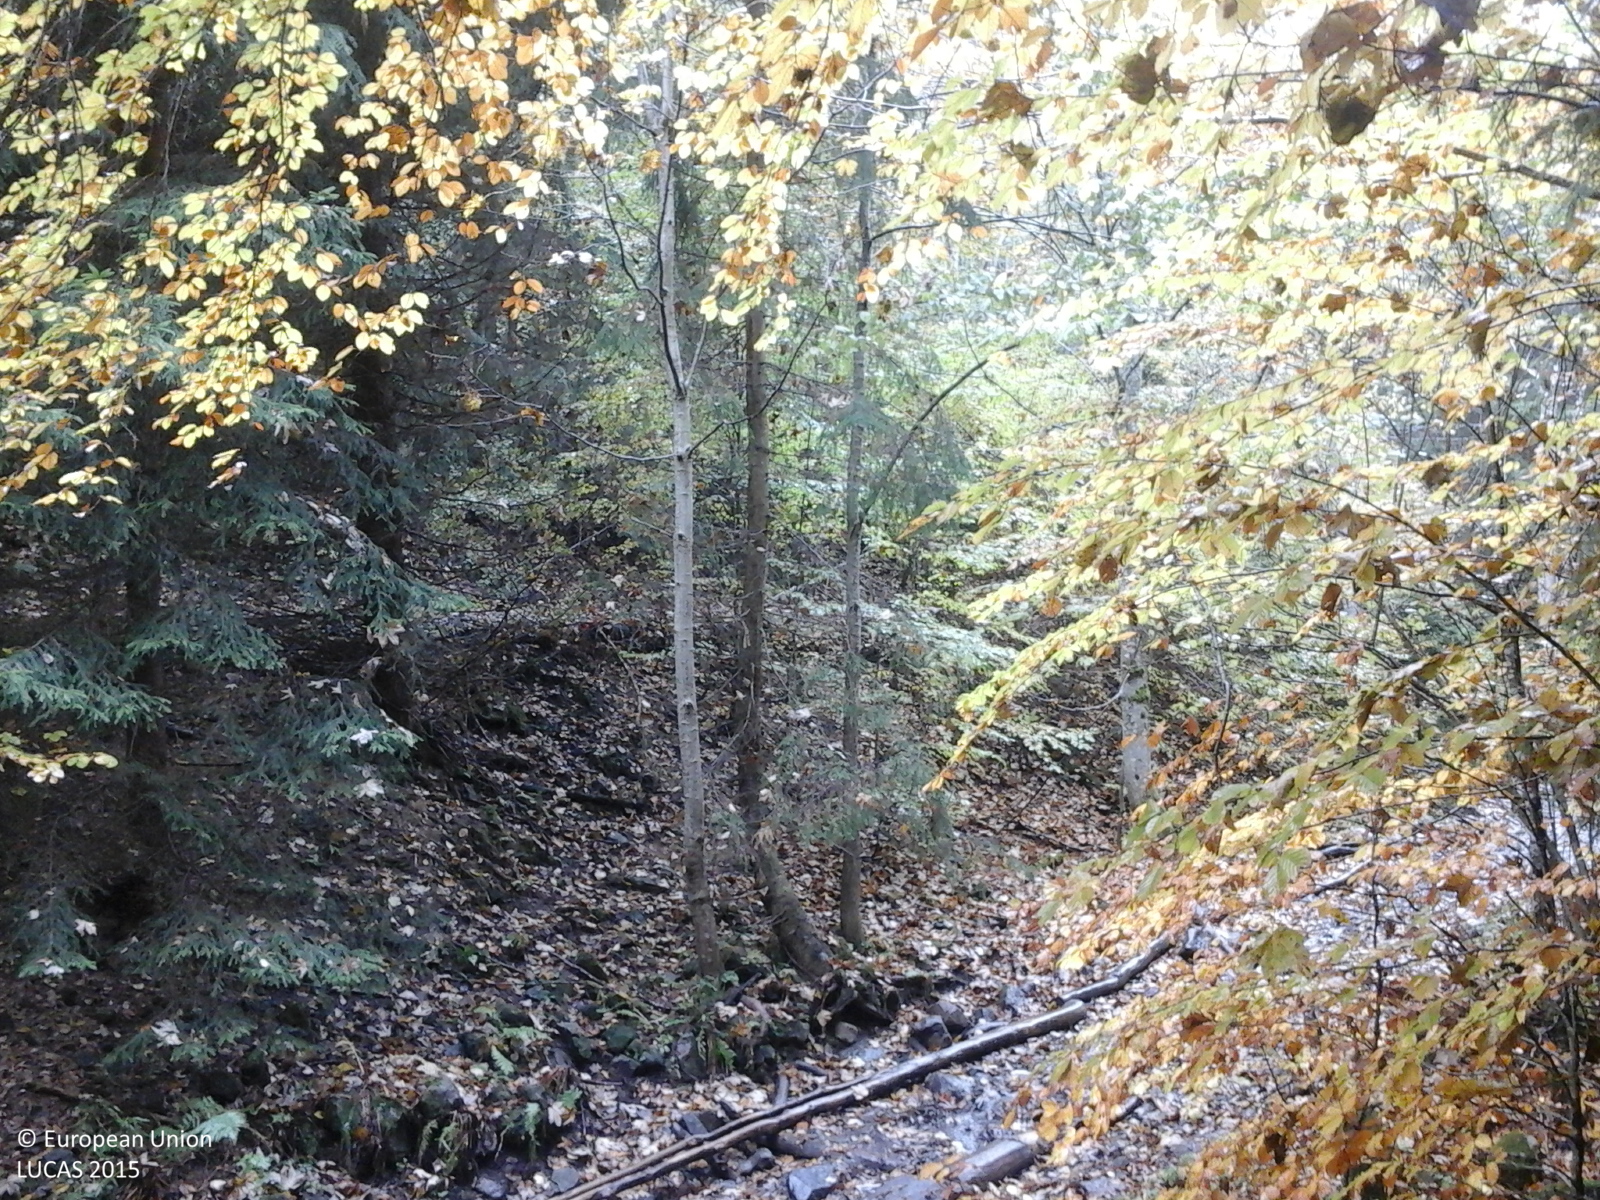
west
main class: Woodland
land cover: Broadleaved woodland
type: beech forest
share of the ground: > 75 %
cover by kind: broadleaved forest trees 100 %
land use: Forestry
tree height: > 5 m
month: October
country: RO
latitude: 46.7764
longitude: 25.2045
